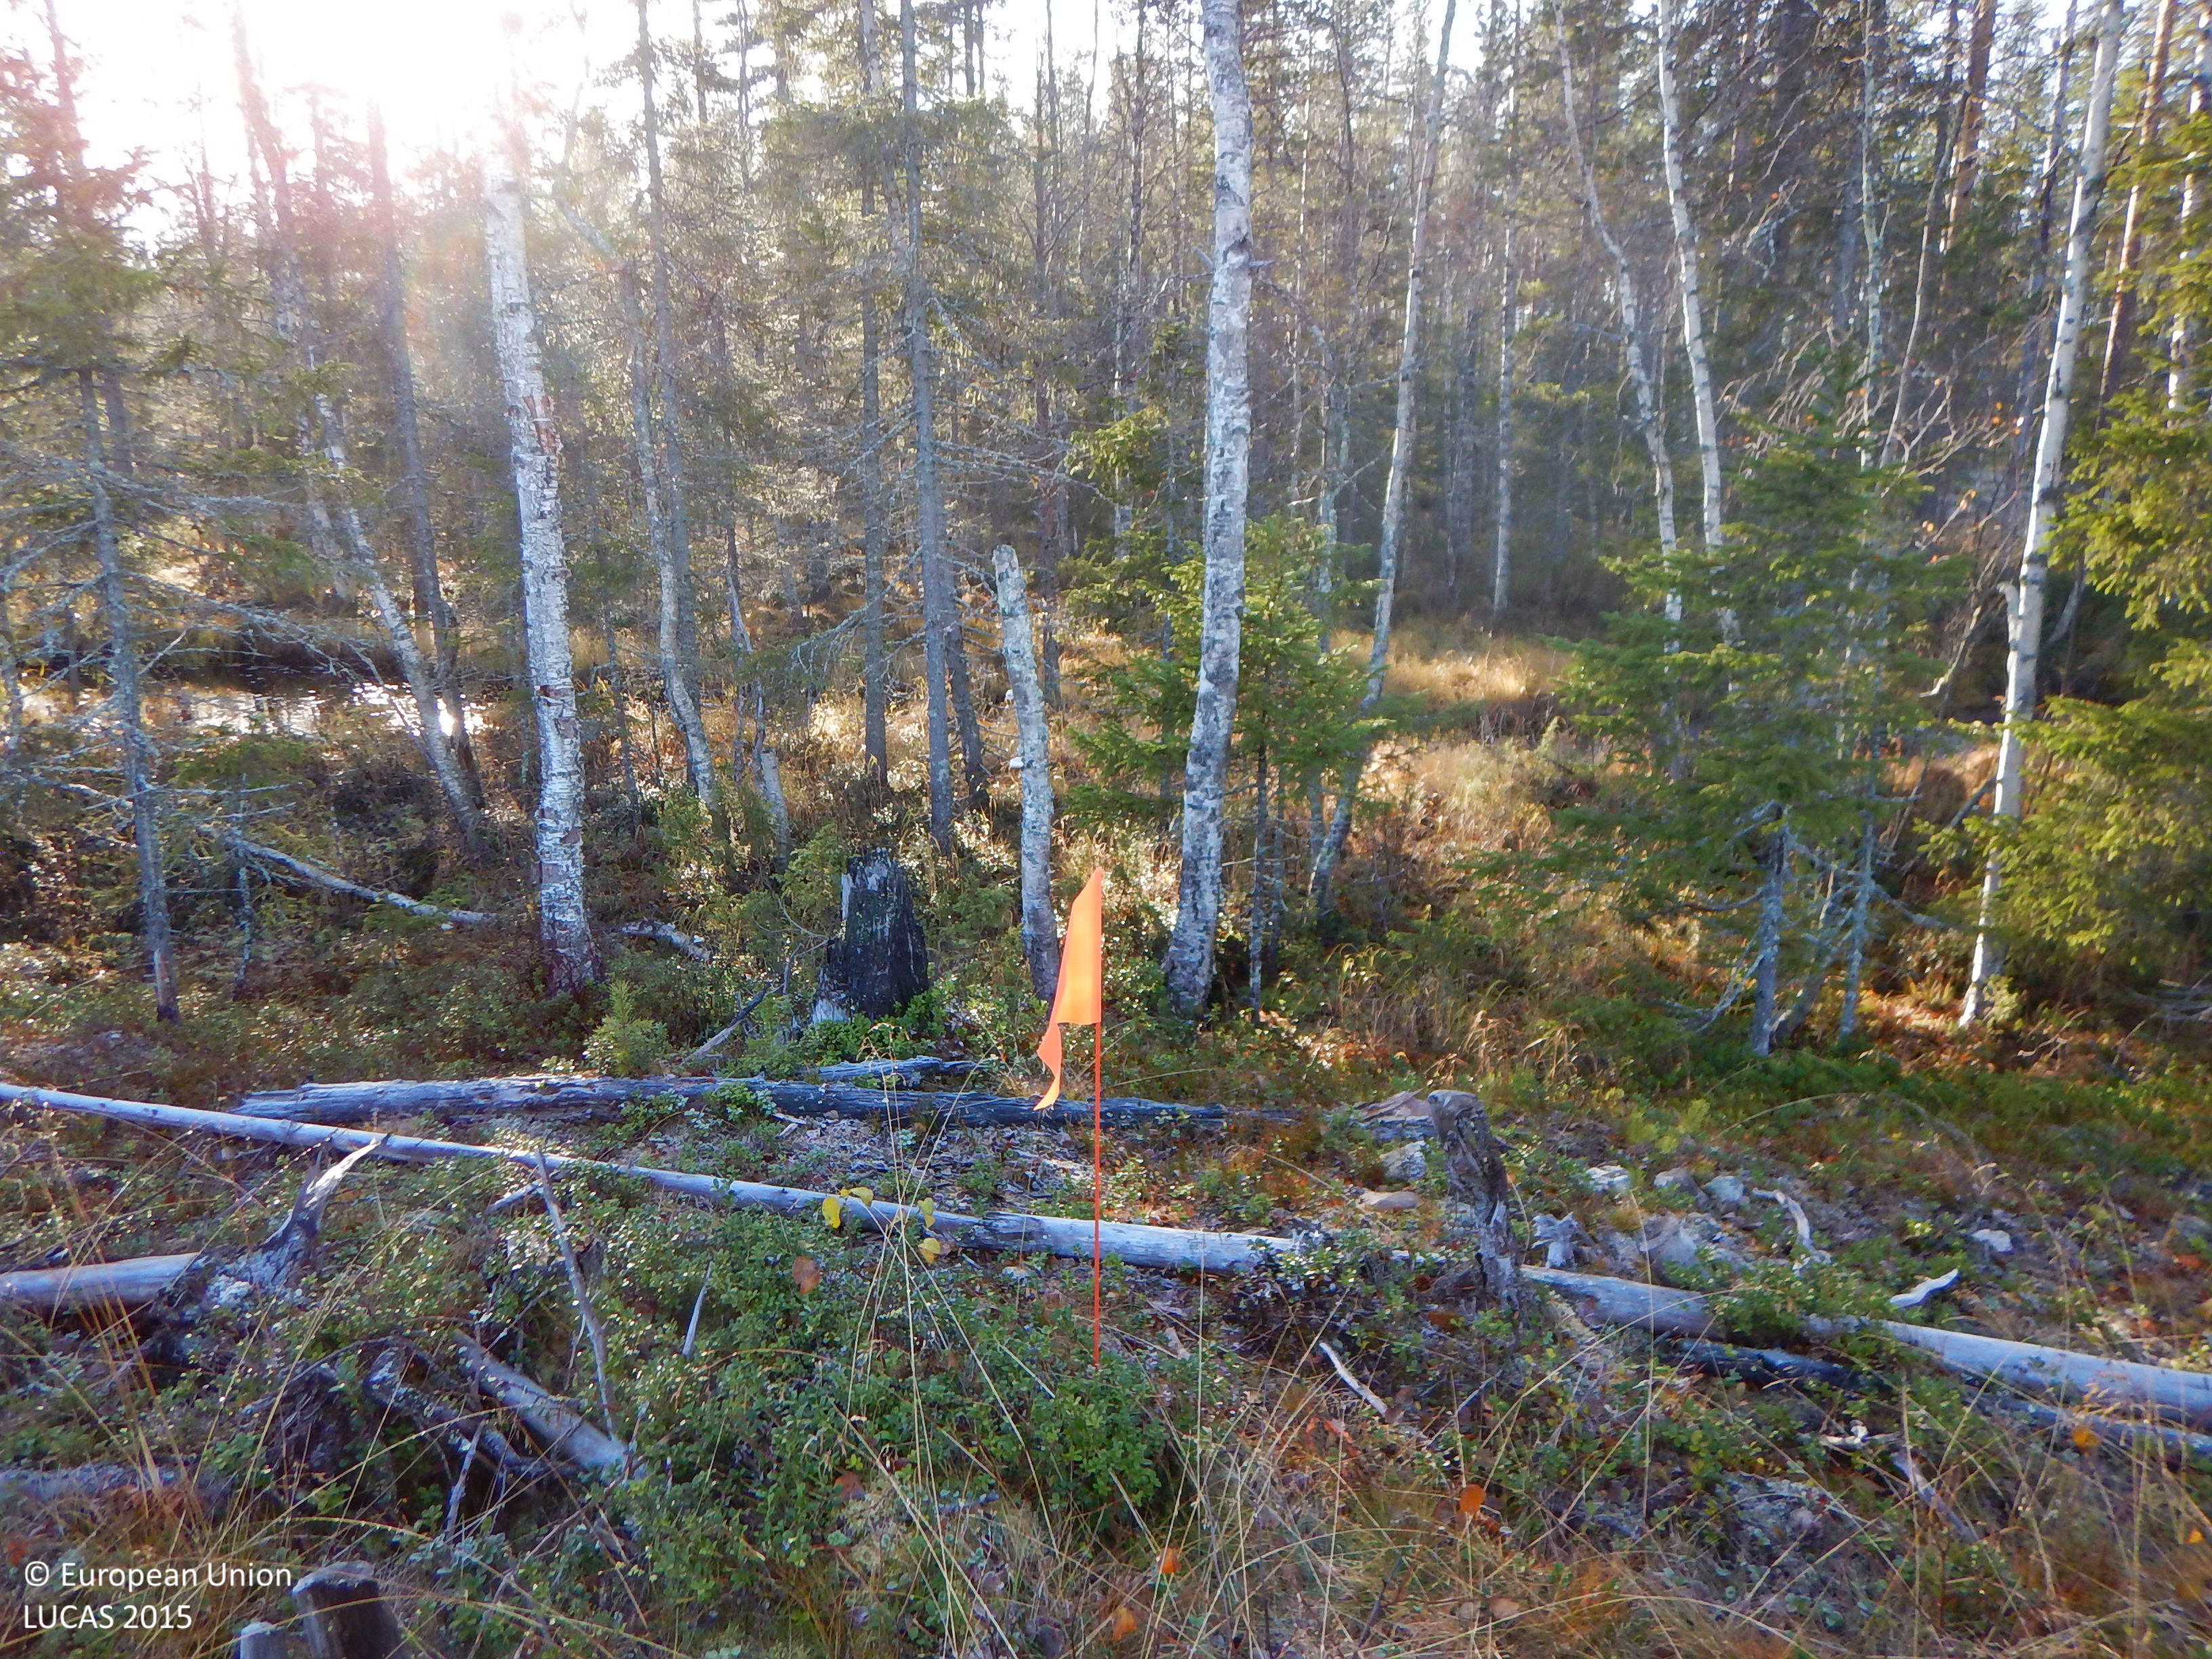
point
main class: Woodland
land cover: Pine dominated coniferous woodland
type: boreal forest
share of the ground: 10 - 25 %
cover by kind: herbaceous plants 40 %, shrubs 30 %, coniferous forest trees 15 %, lichens and mosses 15 %
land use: Forestry
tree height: < 5 m
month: October
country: SE
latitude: 65.1213
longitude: 20.0020
